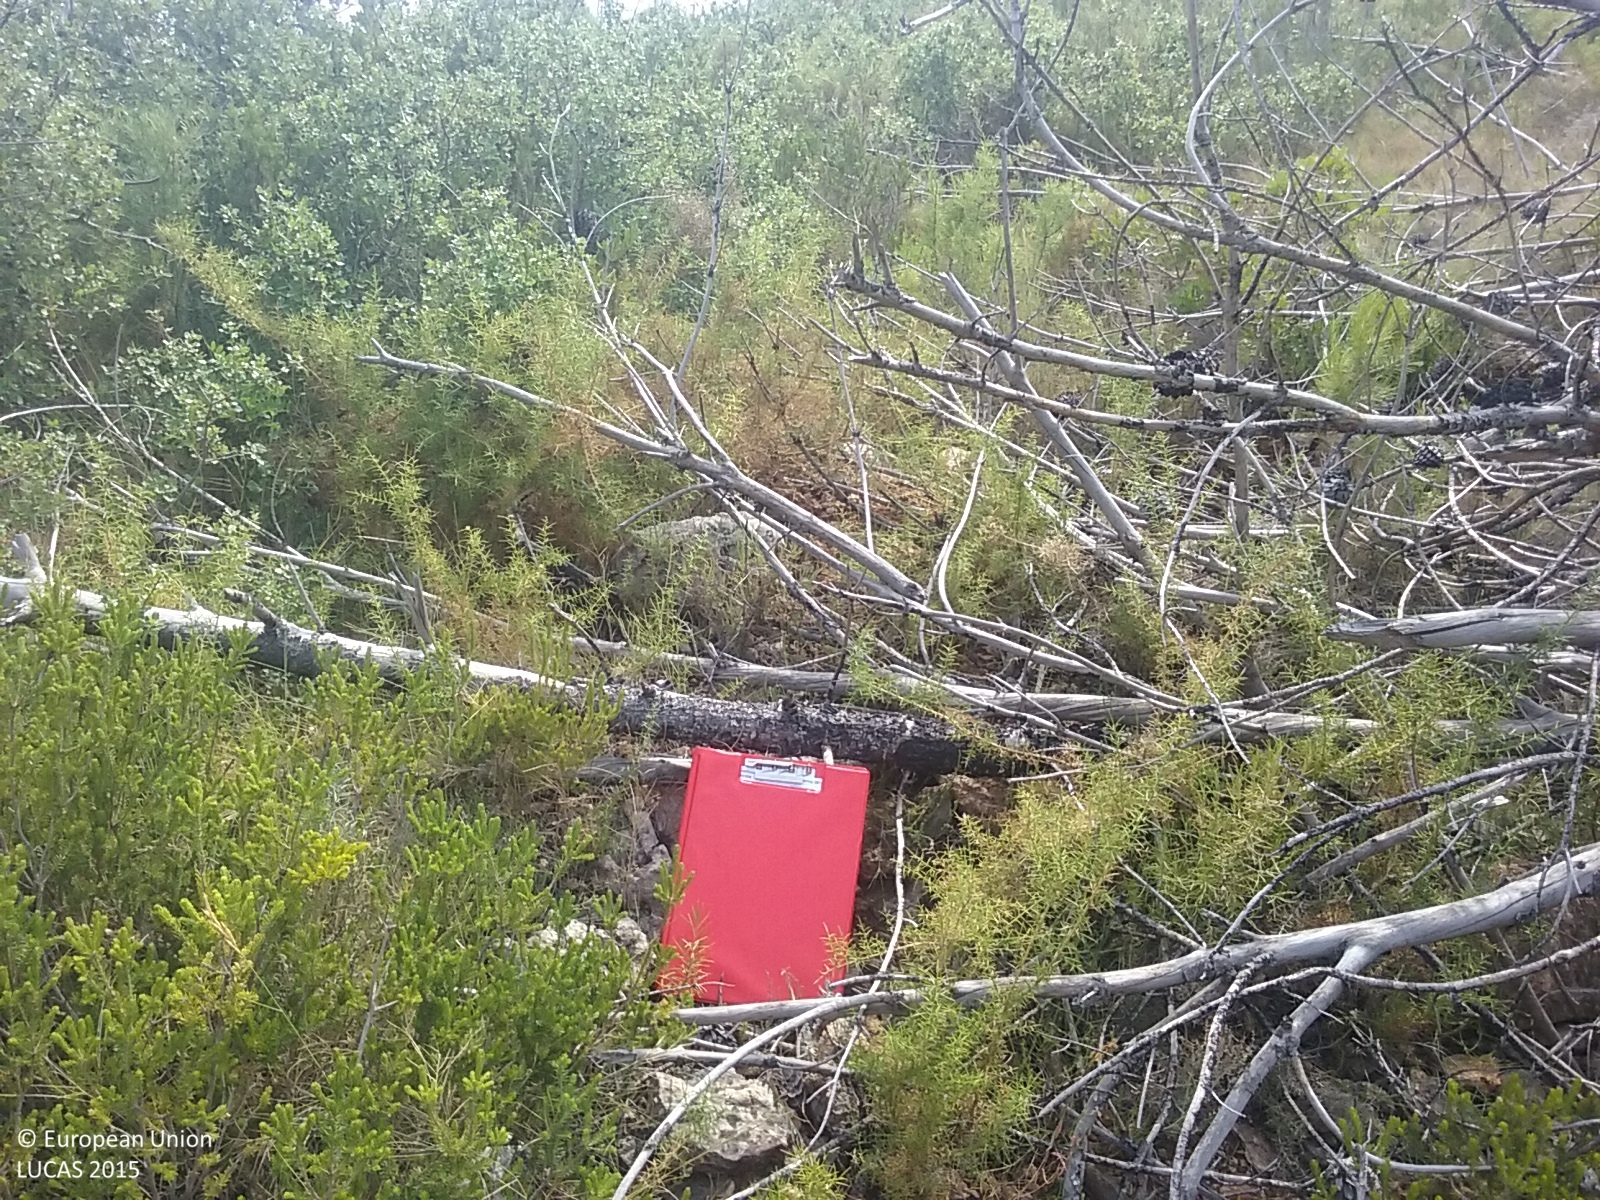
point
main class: Shrubland
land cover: Shrubland with sparse tree cover
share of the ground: > 75 %
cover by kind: shrubs 80 %, herbaceous plants 15 %, coniferous forest trees 5 %
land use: Semi-natural and natural areas not in use
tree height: < 5 m
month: July
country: ES
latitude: 40.1757
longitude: -0.1614
